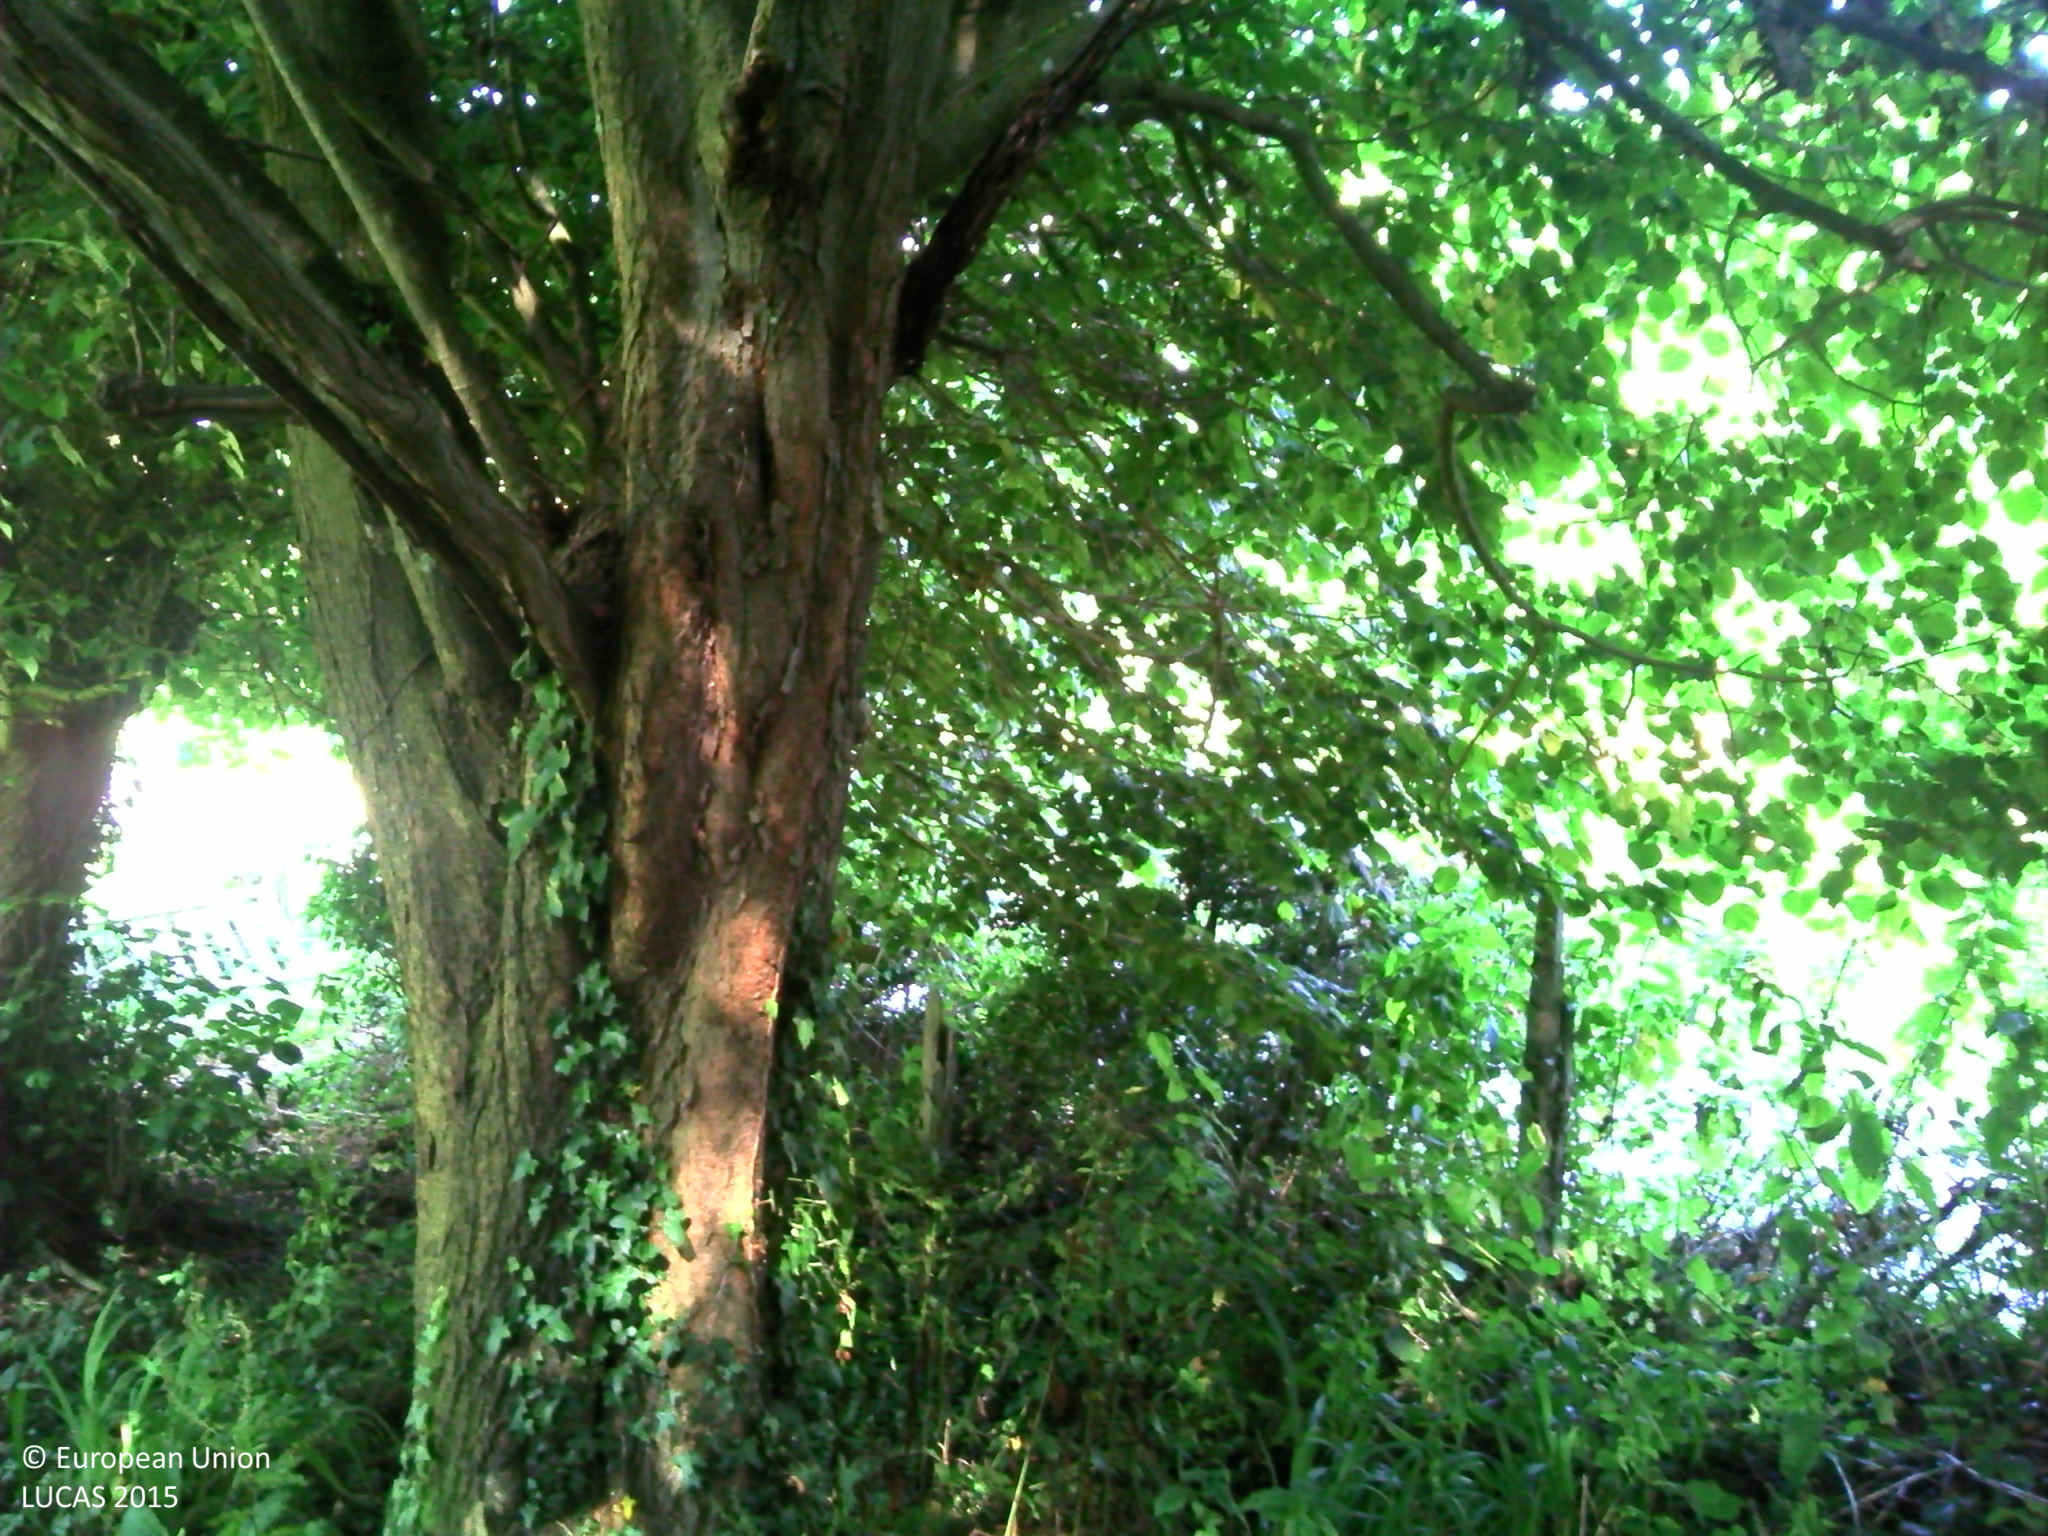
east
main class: Woodland
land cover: Broadleaved woodland
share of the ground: > 75 %
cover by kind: herbaceous plants 50 %, unconsolidated bare surface 30 %, broadleaved forest trees 15 %, coniferous forest trees 5 %
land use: Residential
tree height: > 5 m
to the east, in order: Broadleaved woodland; Artificial constructions in urban areas; Grassland with sparse tree/shrub cover; Fences; Tracks; Broadleaved woodland; Grassland without tree/shrub cover; Broadleaved woodland; Fences; Grassland without tree/shrub cover; Fences; Broadleaved woodland; Rivers and streams; Tracks
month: July
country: FR
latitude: 48.7976
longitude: -3.4616
